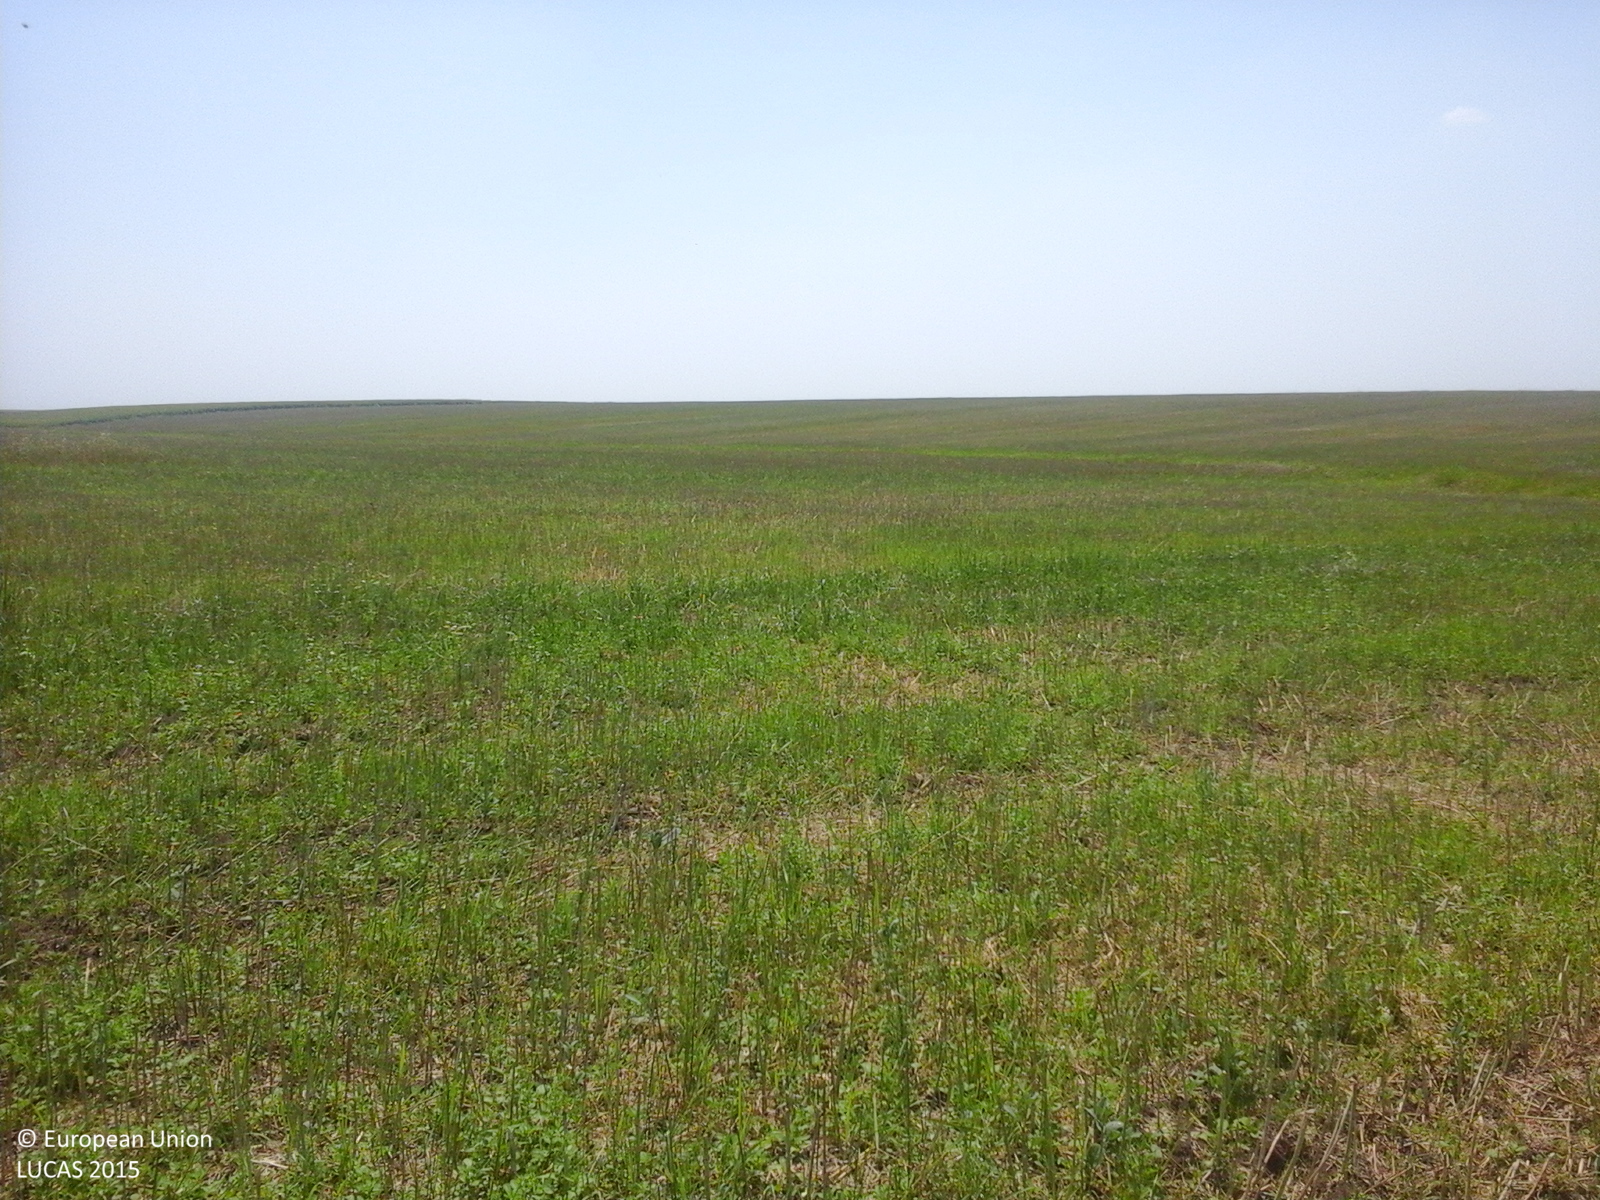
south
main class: Cropland
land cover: Rape and turnip rape
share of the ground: 10 - 25 %
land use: Agriculture (excluding fallow land and kitchen gardens)
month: July
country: RO
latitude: 44.4835
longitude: 24.8516
